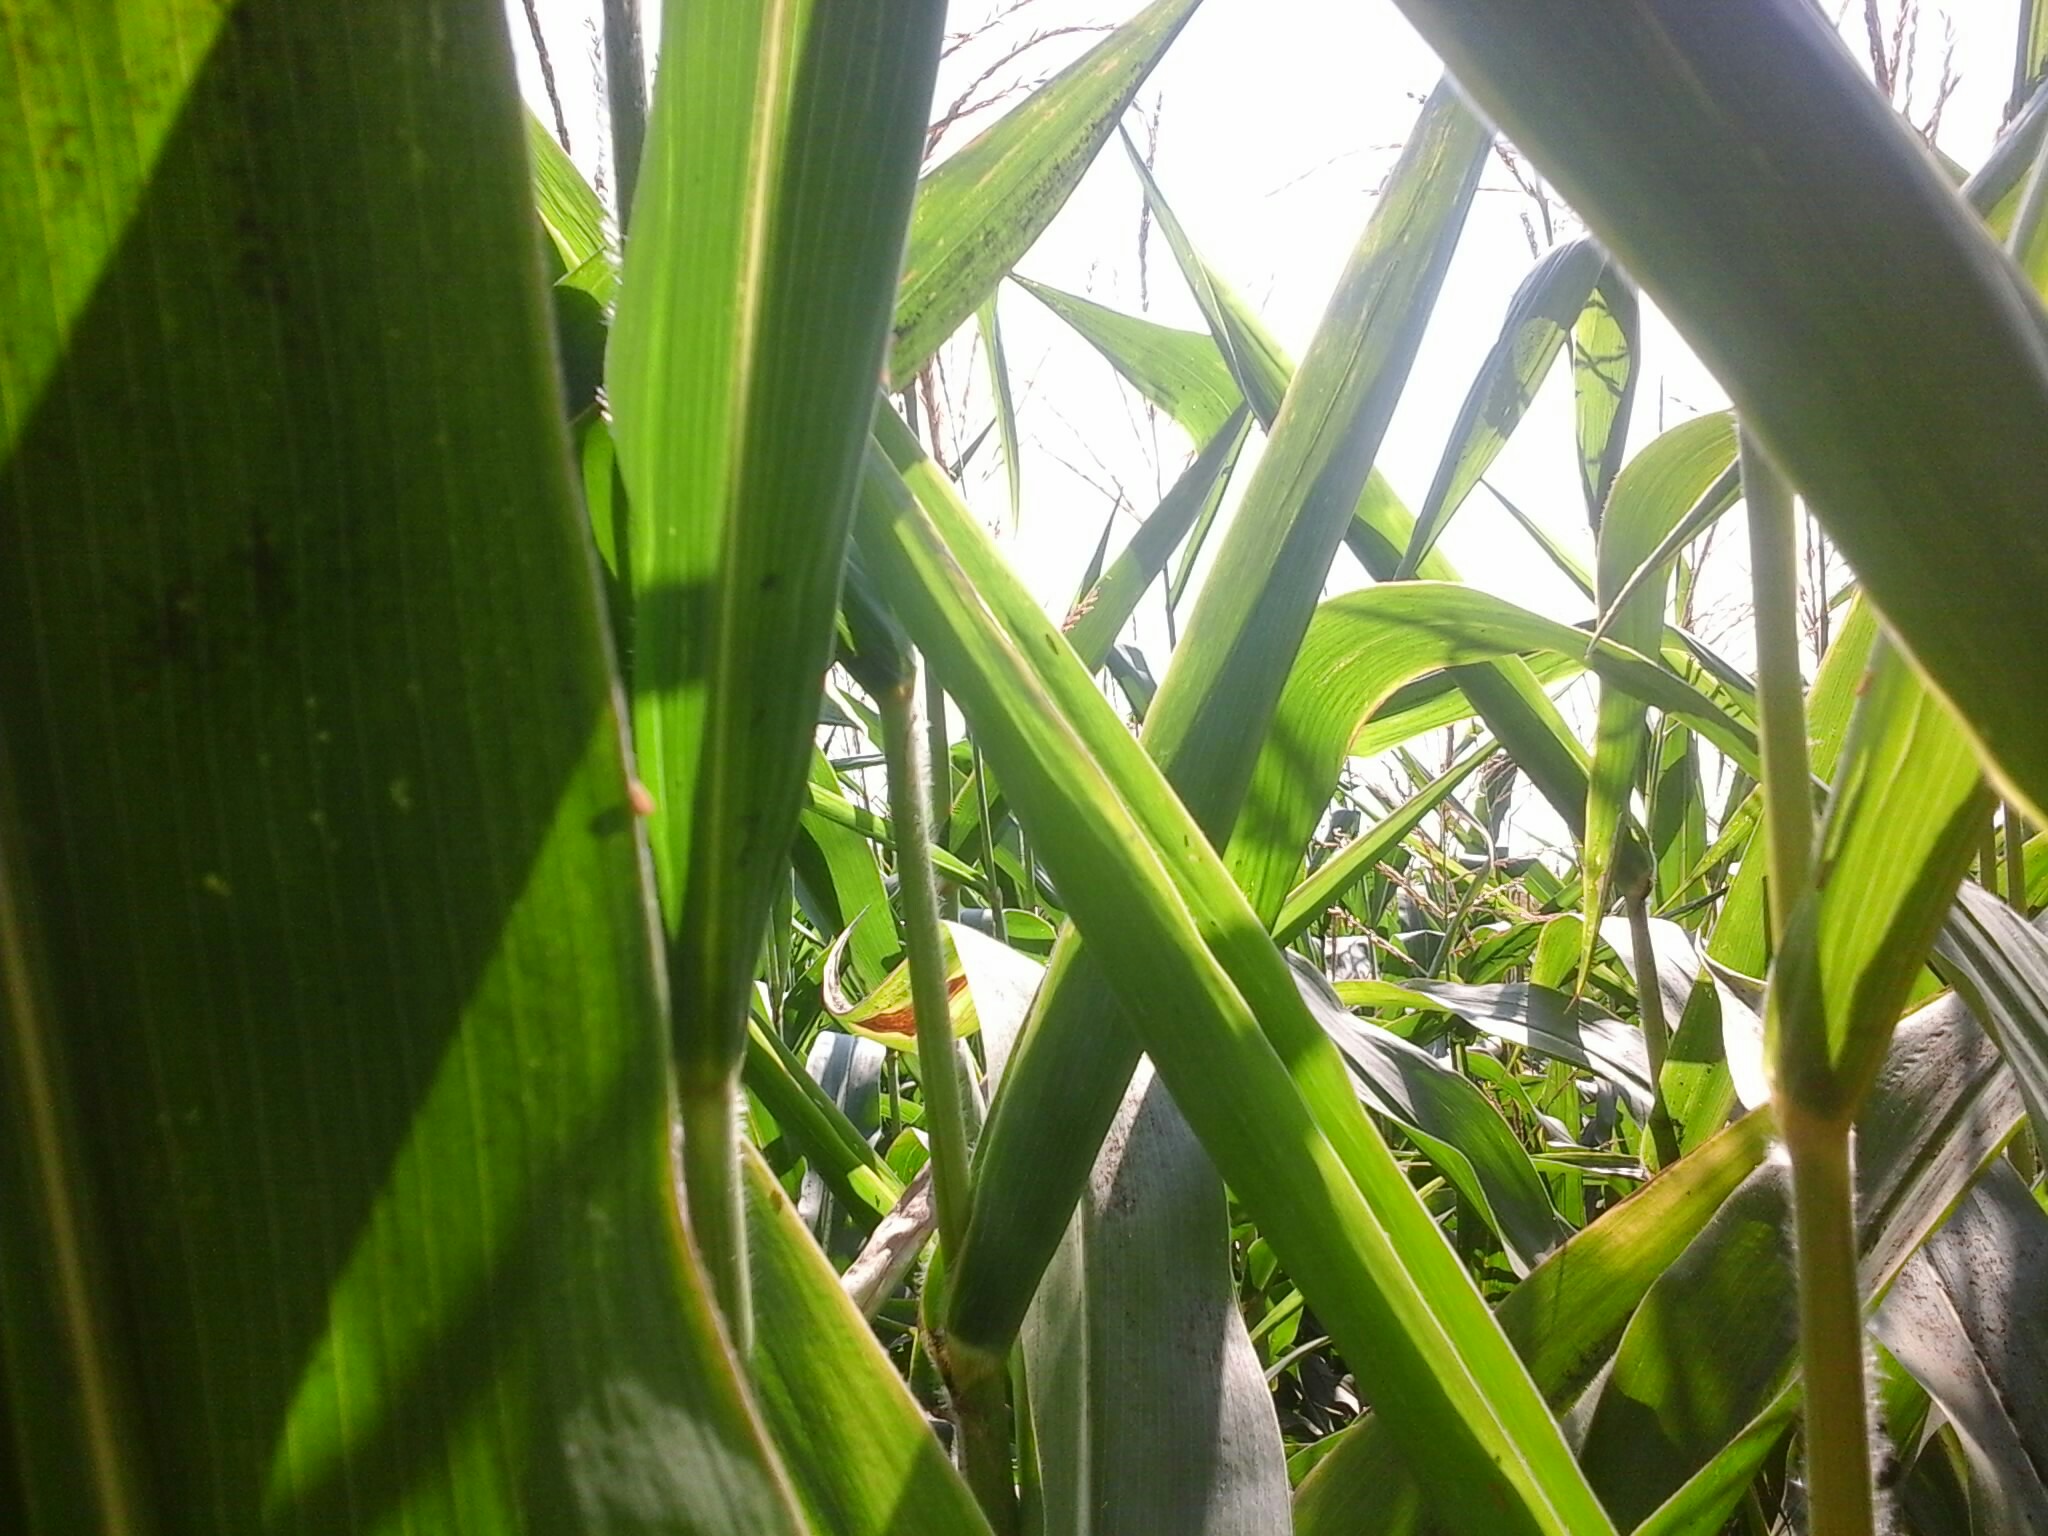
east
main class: Cropland
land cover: Maize
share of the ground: > 75 %
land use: Agriculture (excluding fallow land and kitchen gardens)
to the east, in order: Maize; Tomatoes; Other fresh vegetables; Dry pulses; Maize; Artificial constructions in urban areas
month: August
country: HU
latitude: 47.6501
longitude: 17.9053
